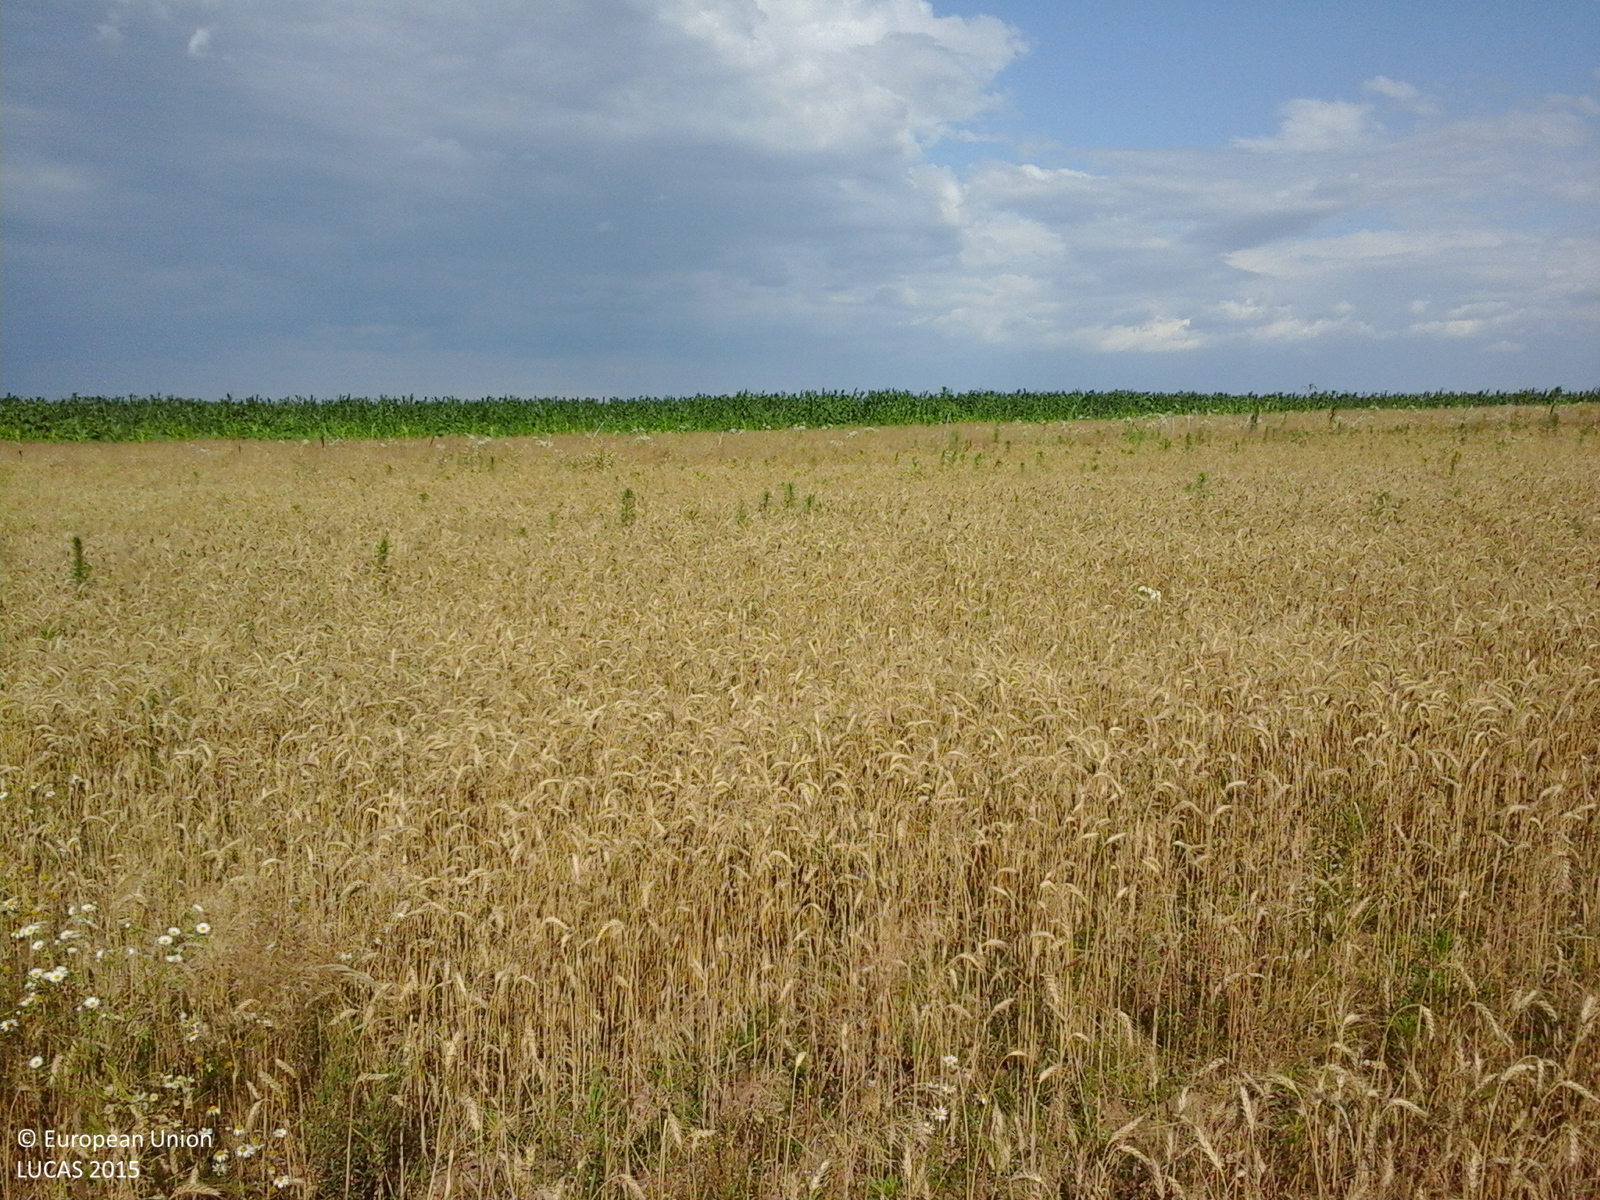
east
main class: Cropland
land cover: Common wheat
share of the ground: > 75 %
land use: Agriculture (excluding fallow land and kitchen gardens)
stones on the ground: < 10 %
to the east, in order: Common wheat; Maize; Common wheat; Maize; Spontaneously vegetated surfaces; Rye; Grassland without tree/shrub cover
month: July
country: RO
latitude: 44.3248
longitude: 24.8094
